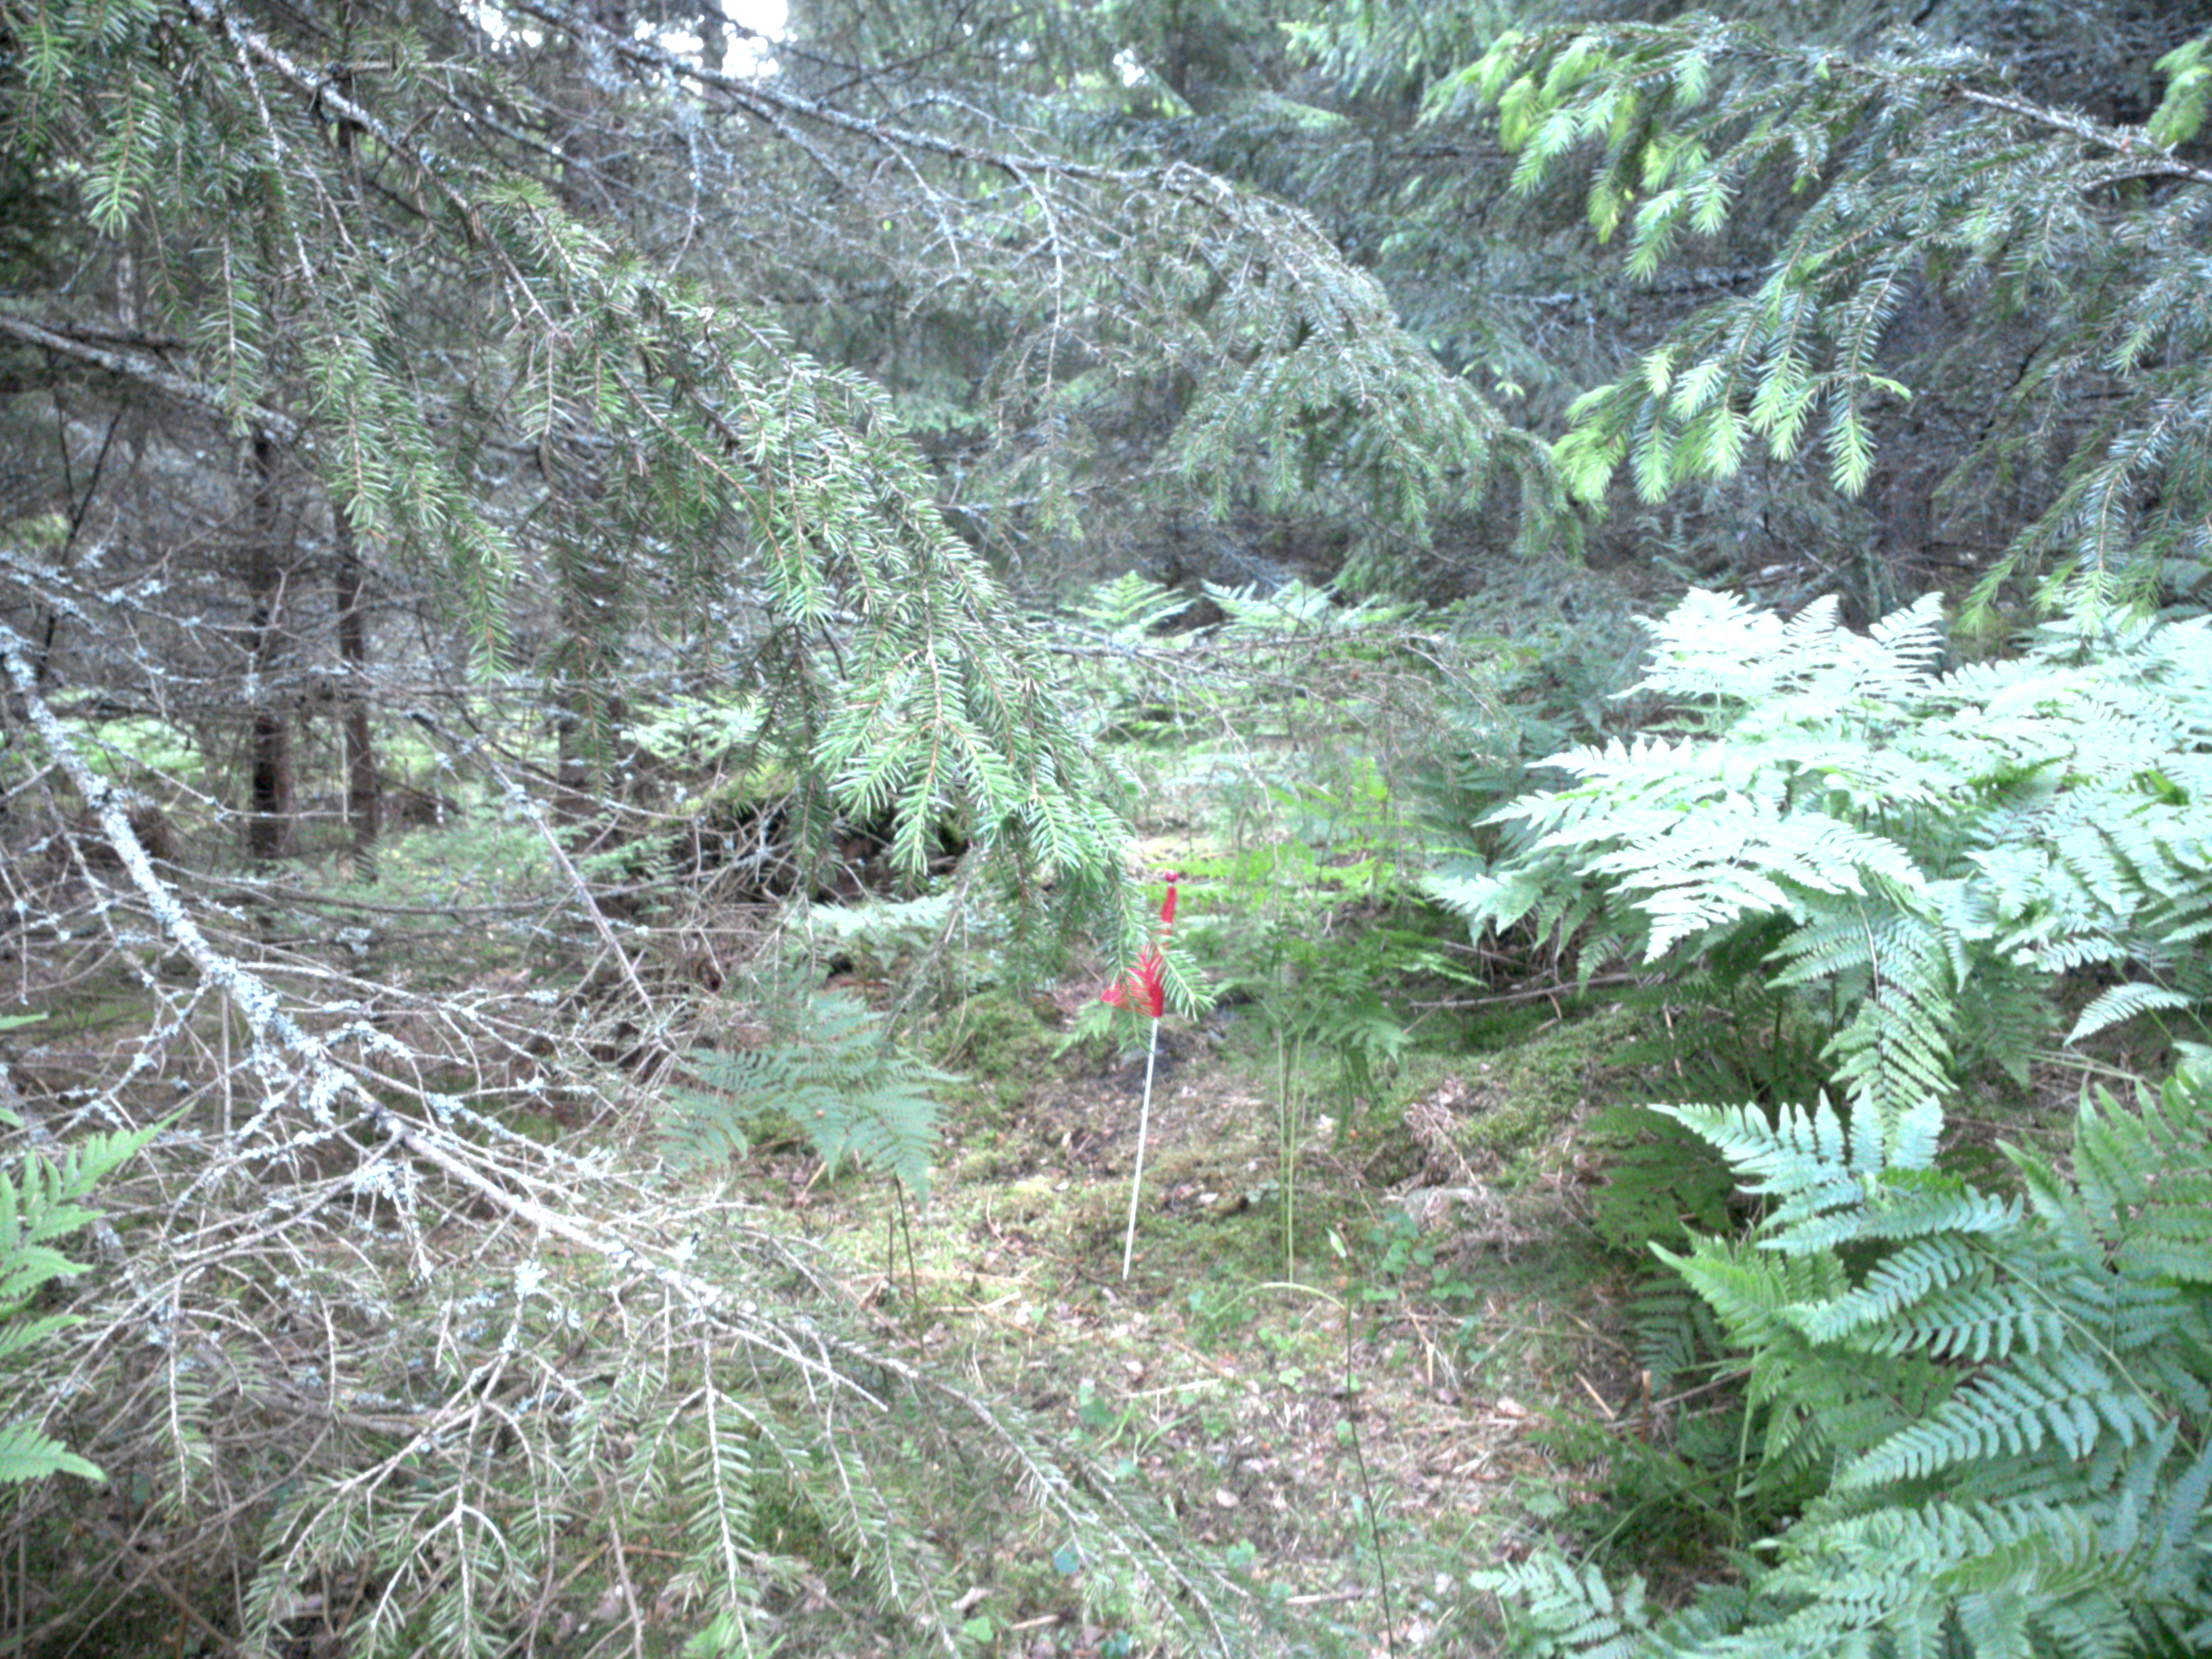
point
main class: Woodland
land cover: Spruce dominated coniferous woodland
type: boreal forest
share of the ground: > 75 %
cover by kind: coniferous forest trees 85 %, lichens and mosses 15 %
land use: Forestry
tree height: > 5 m
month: June
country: SE
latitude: 59.2046
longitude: 17.4740
